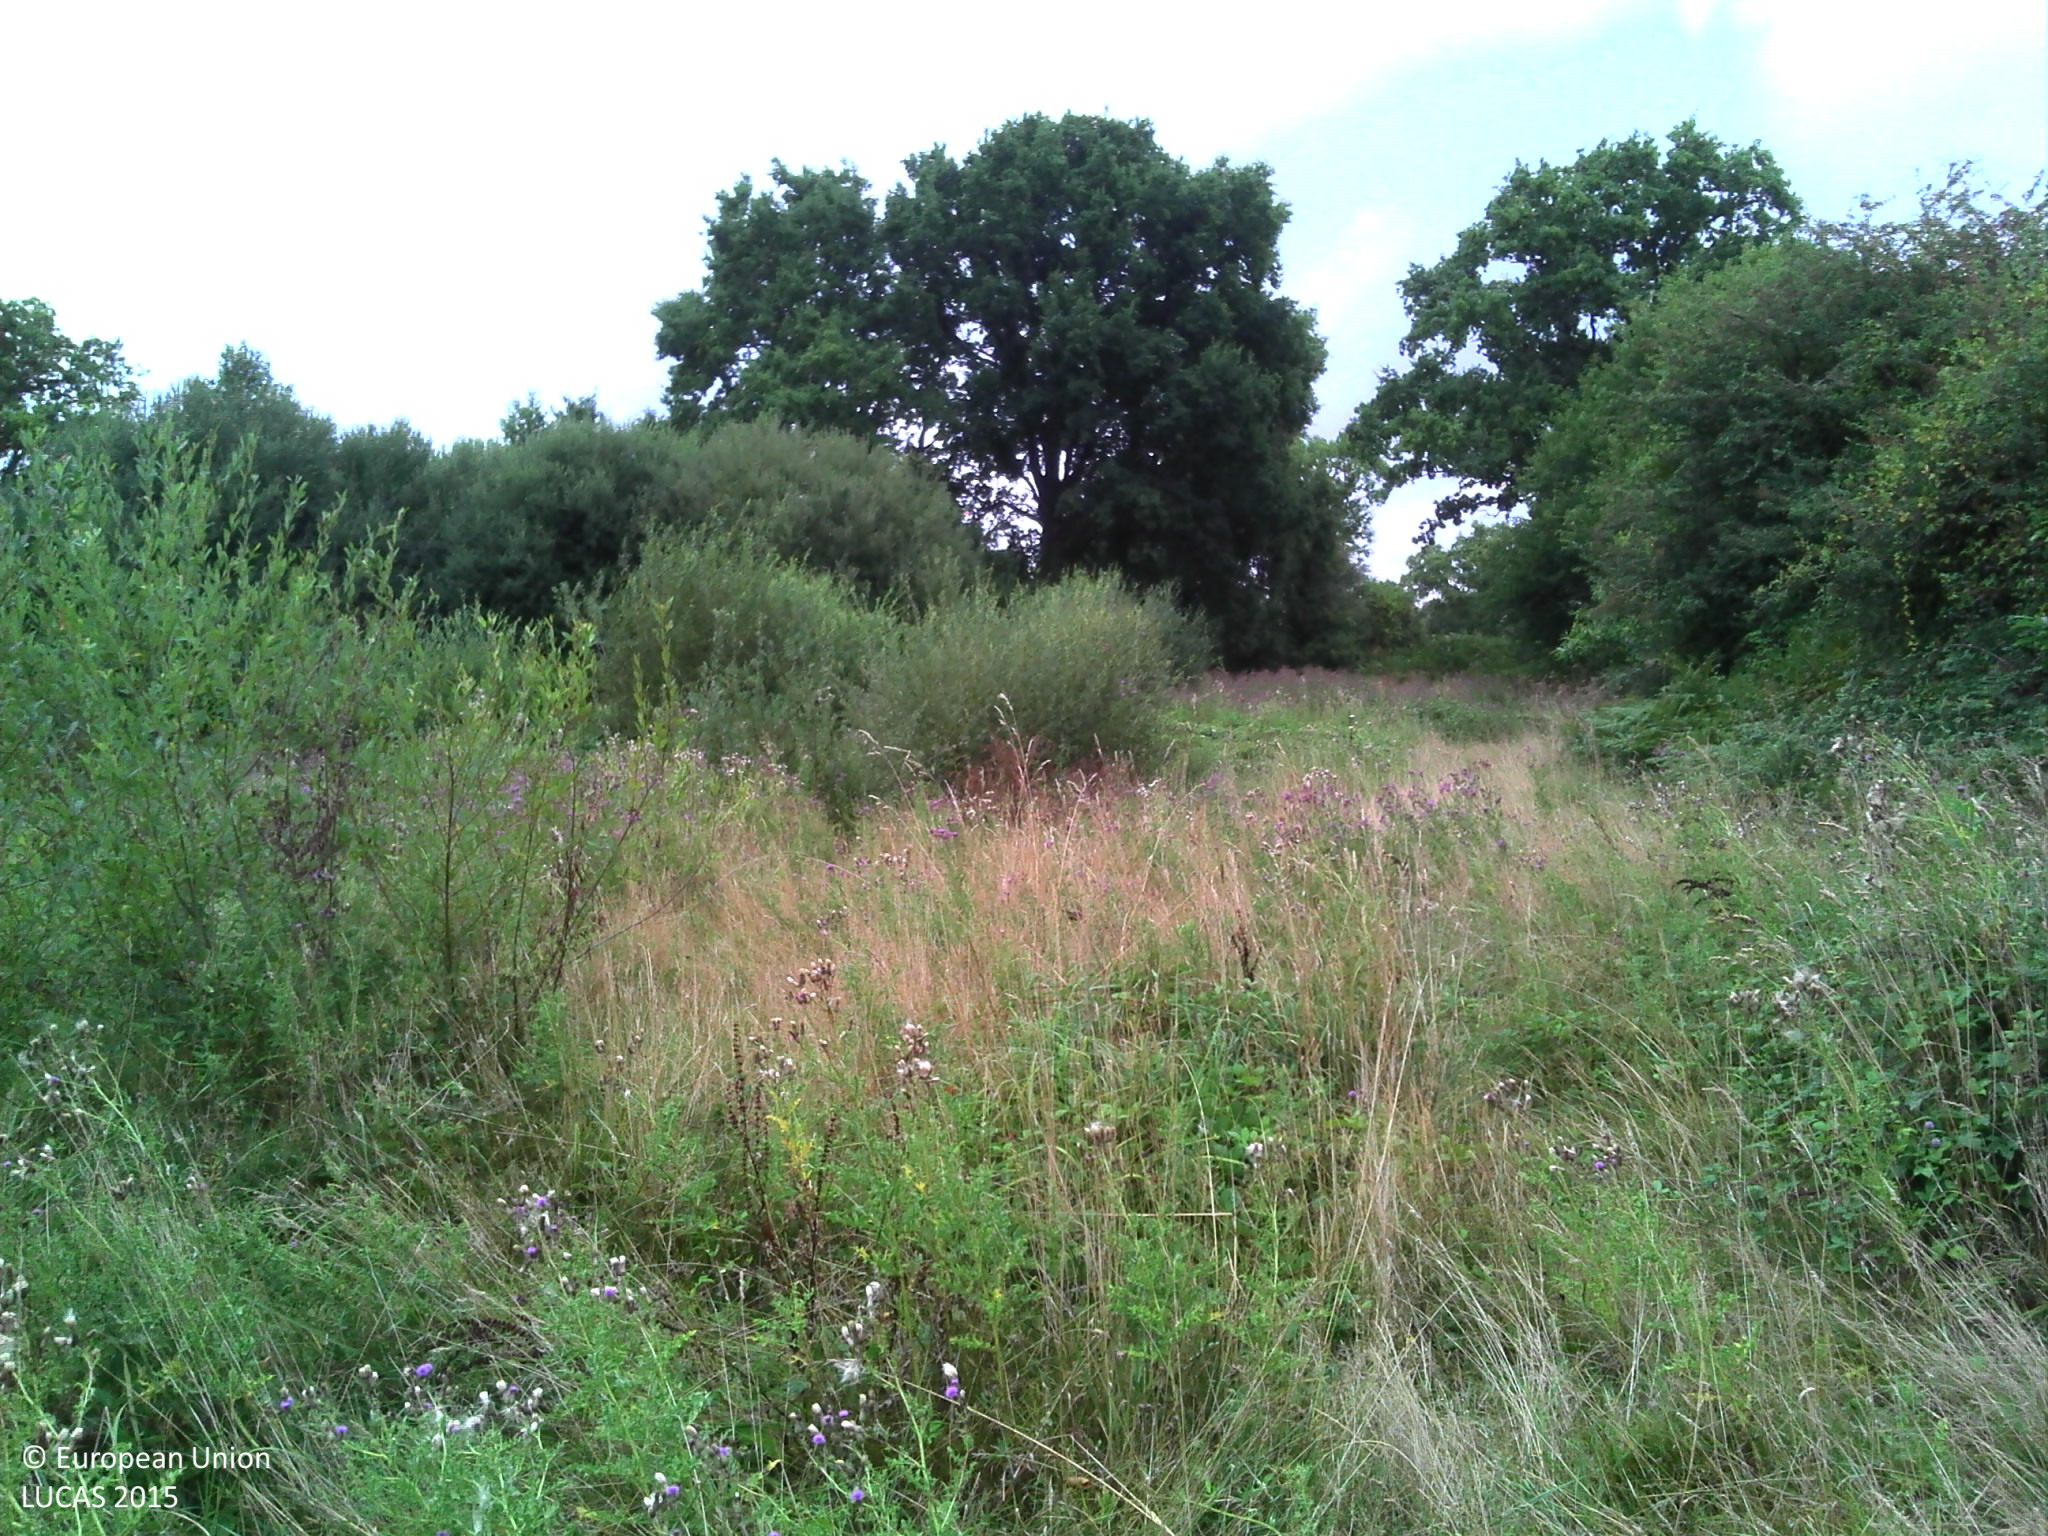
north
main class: Grassland
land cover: Spontaneously vegetated surfaces
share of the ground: > 75 %
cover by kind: herbaceous plants 95 %, shrubs 5 %
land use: Abandoned areas
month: August
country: FR
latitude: 47.5635
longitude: -1.5136
